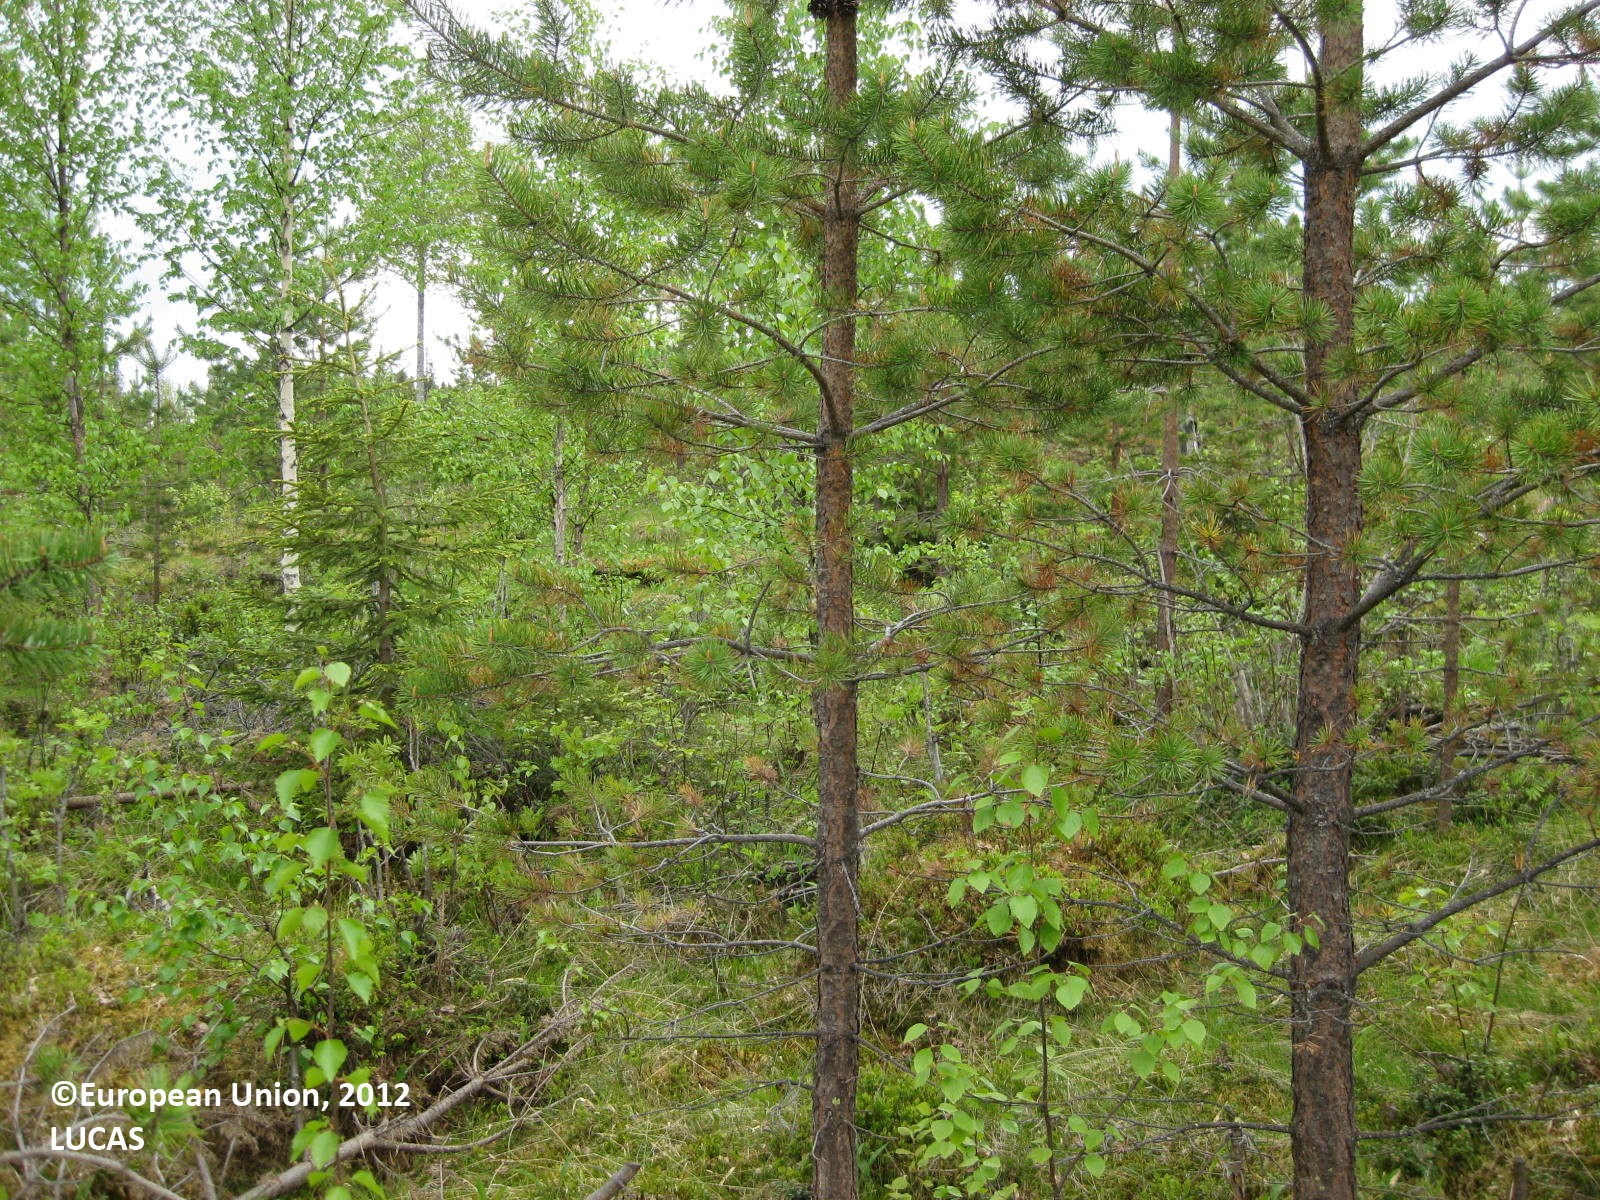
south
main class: Woodland
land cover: Pine dominated mixed woodland
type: boreal forest
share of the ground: 50 - 75 %
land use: Forestry
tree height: < 5 m
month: June
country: FI
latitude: 65.2240
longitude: 28.9366
